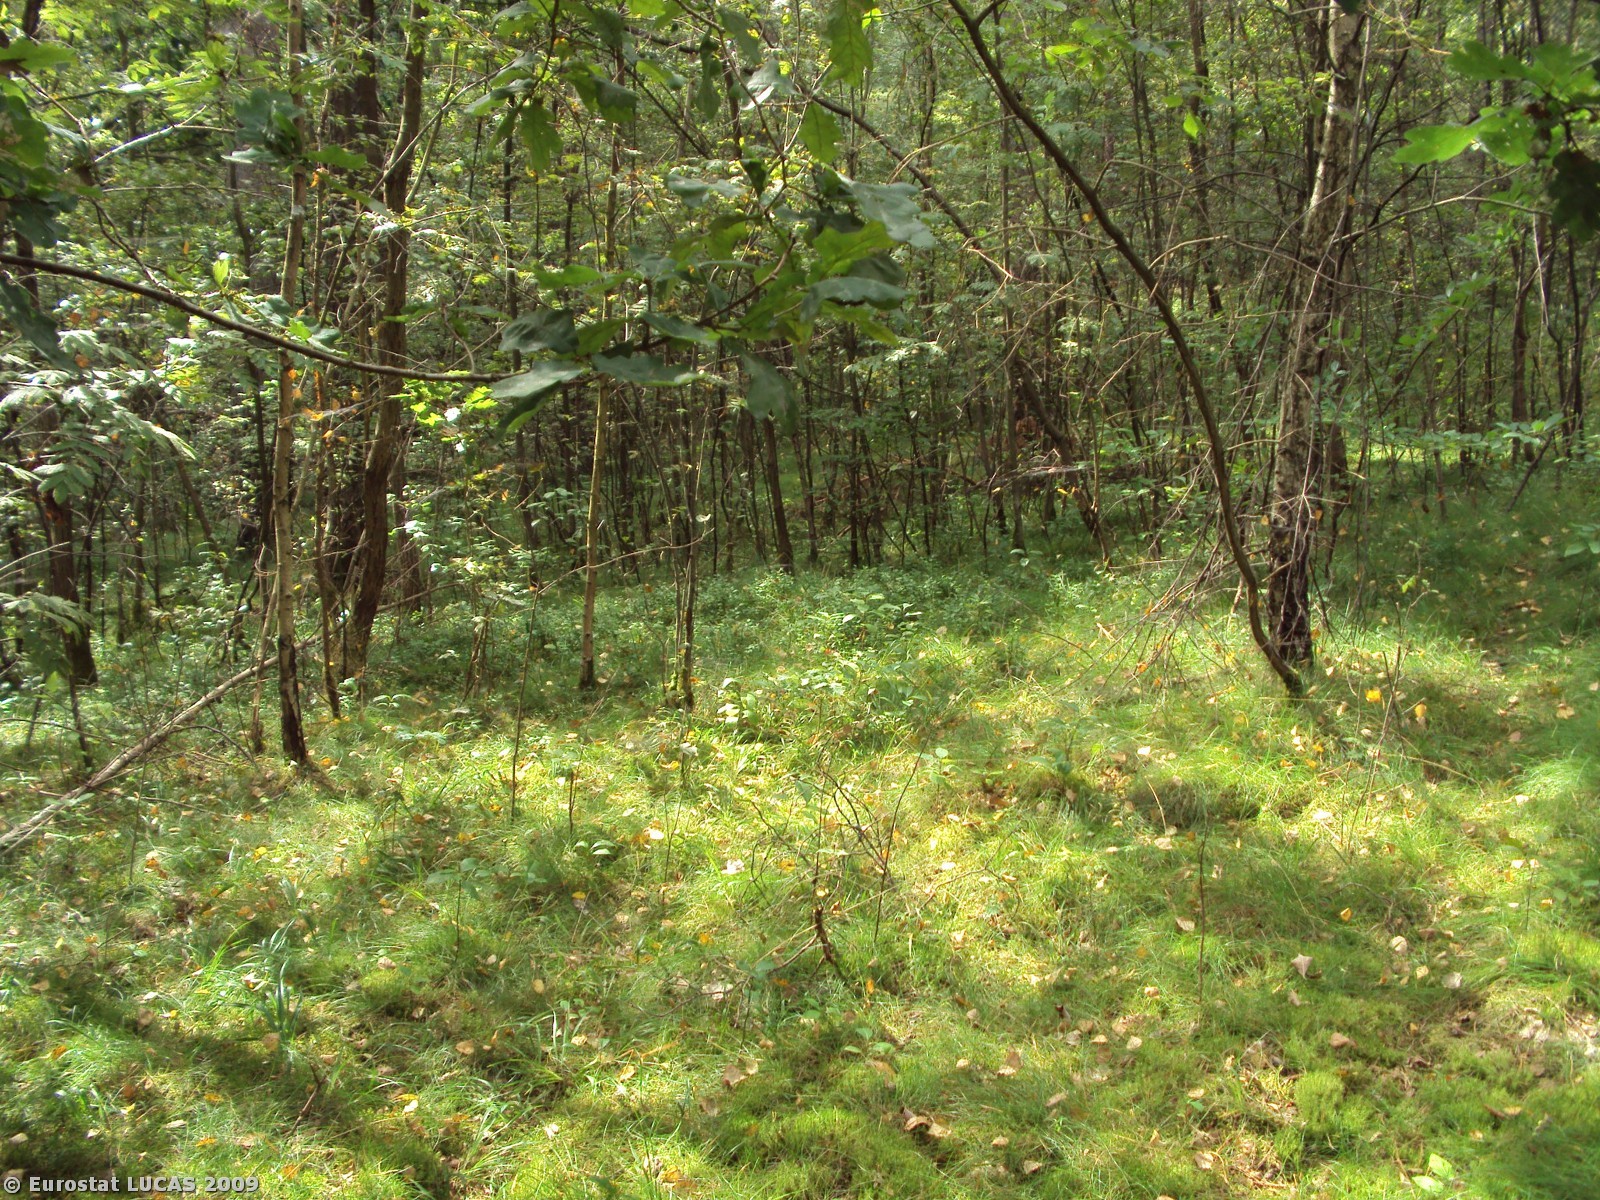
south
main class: Woodland
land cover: Mixed woodland
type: hemiboreal forest and nemoral coniferous forest and mixed broadleaved-coniferous forest
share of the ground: > 75 %
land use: Forestry
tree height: > 5 m
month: August
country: PL
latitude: 53.5871
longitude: 16.5177
